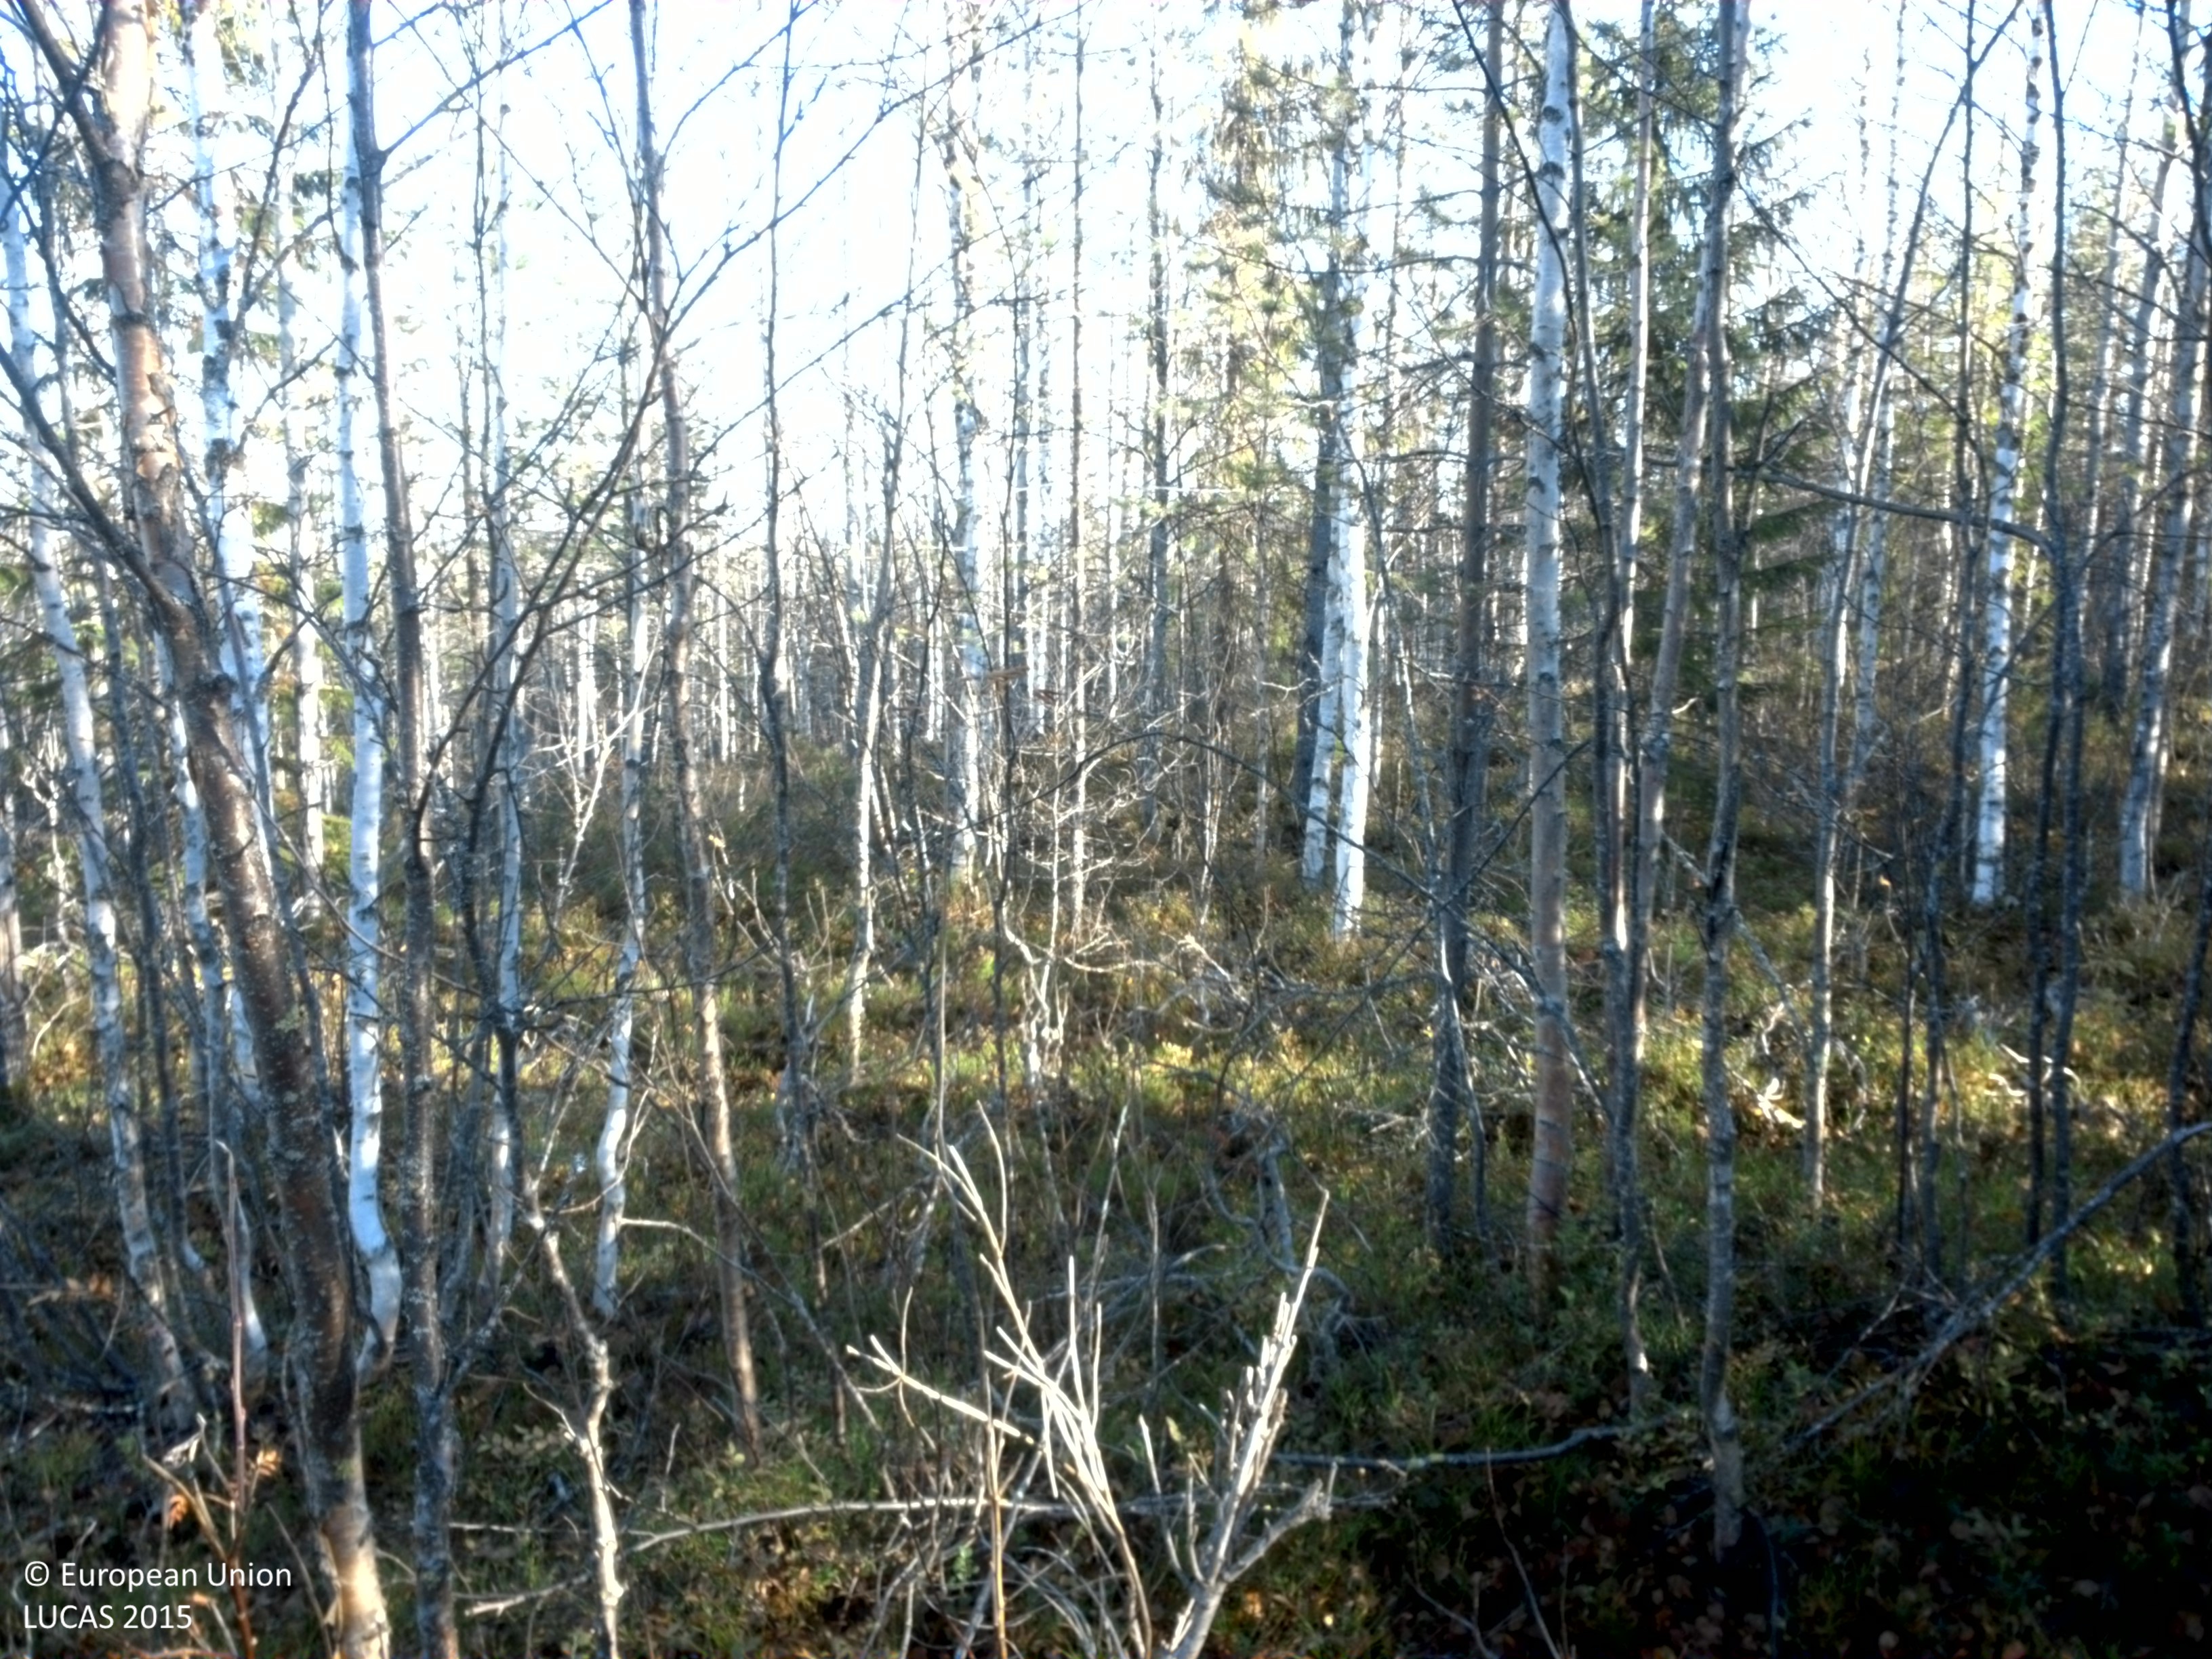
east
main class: Woodland
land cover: Broadleaved woodland
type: non-riverine alder, birch or aspen forest
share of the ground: 25 - 50 %
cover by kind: shrubs 40 %, broadleaved forest trees 35 %, lichens and mosses 15 %, coniferous forest trees 5 %, herbaceous plants 5 %
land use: Forestry
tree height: > 5 m
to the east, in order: Broadleaved woodland; Pine dominated mixed woodland
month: October
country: SE
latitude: 64.5714
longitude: 16.5423
